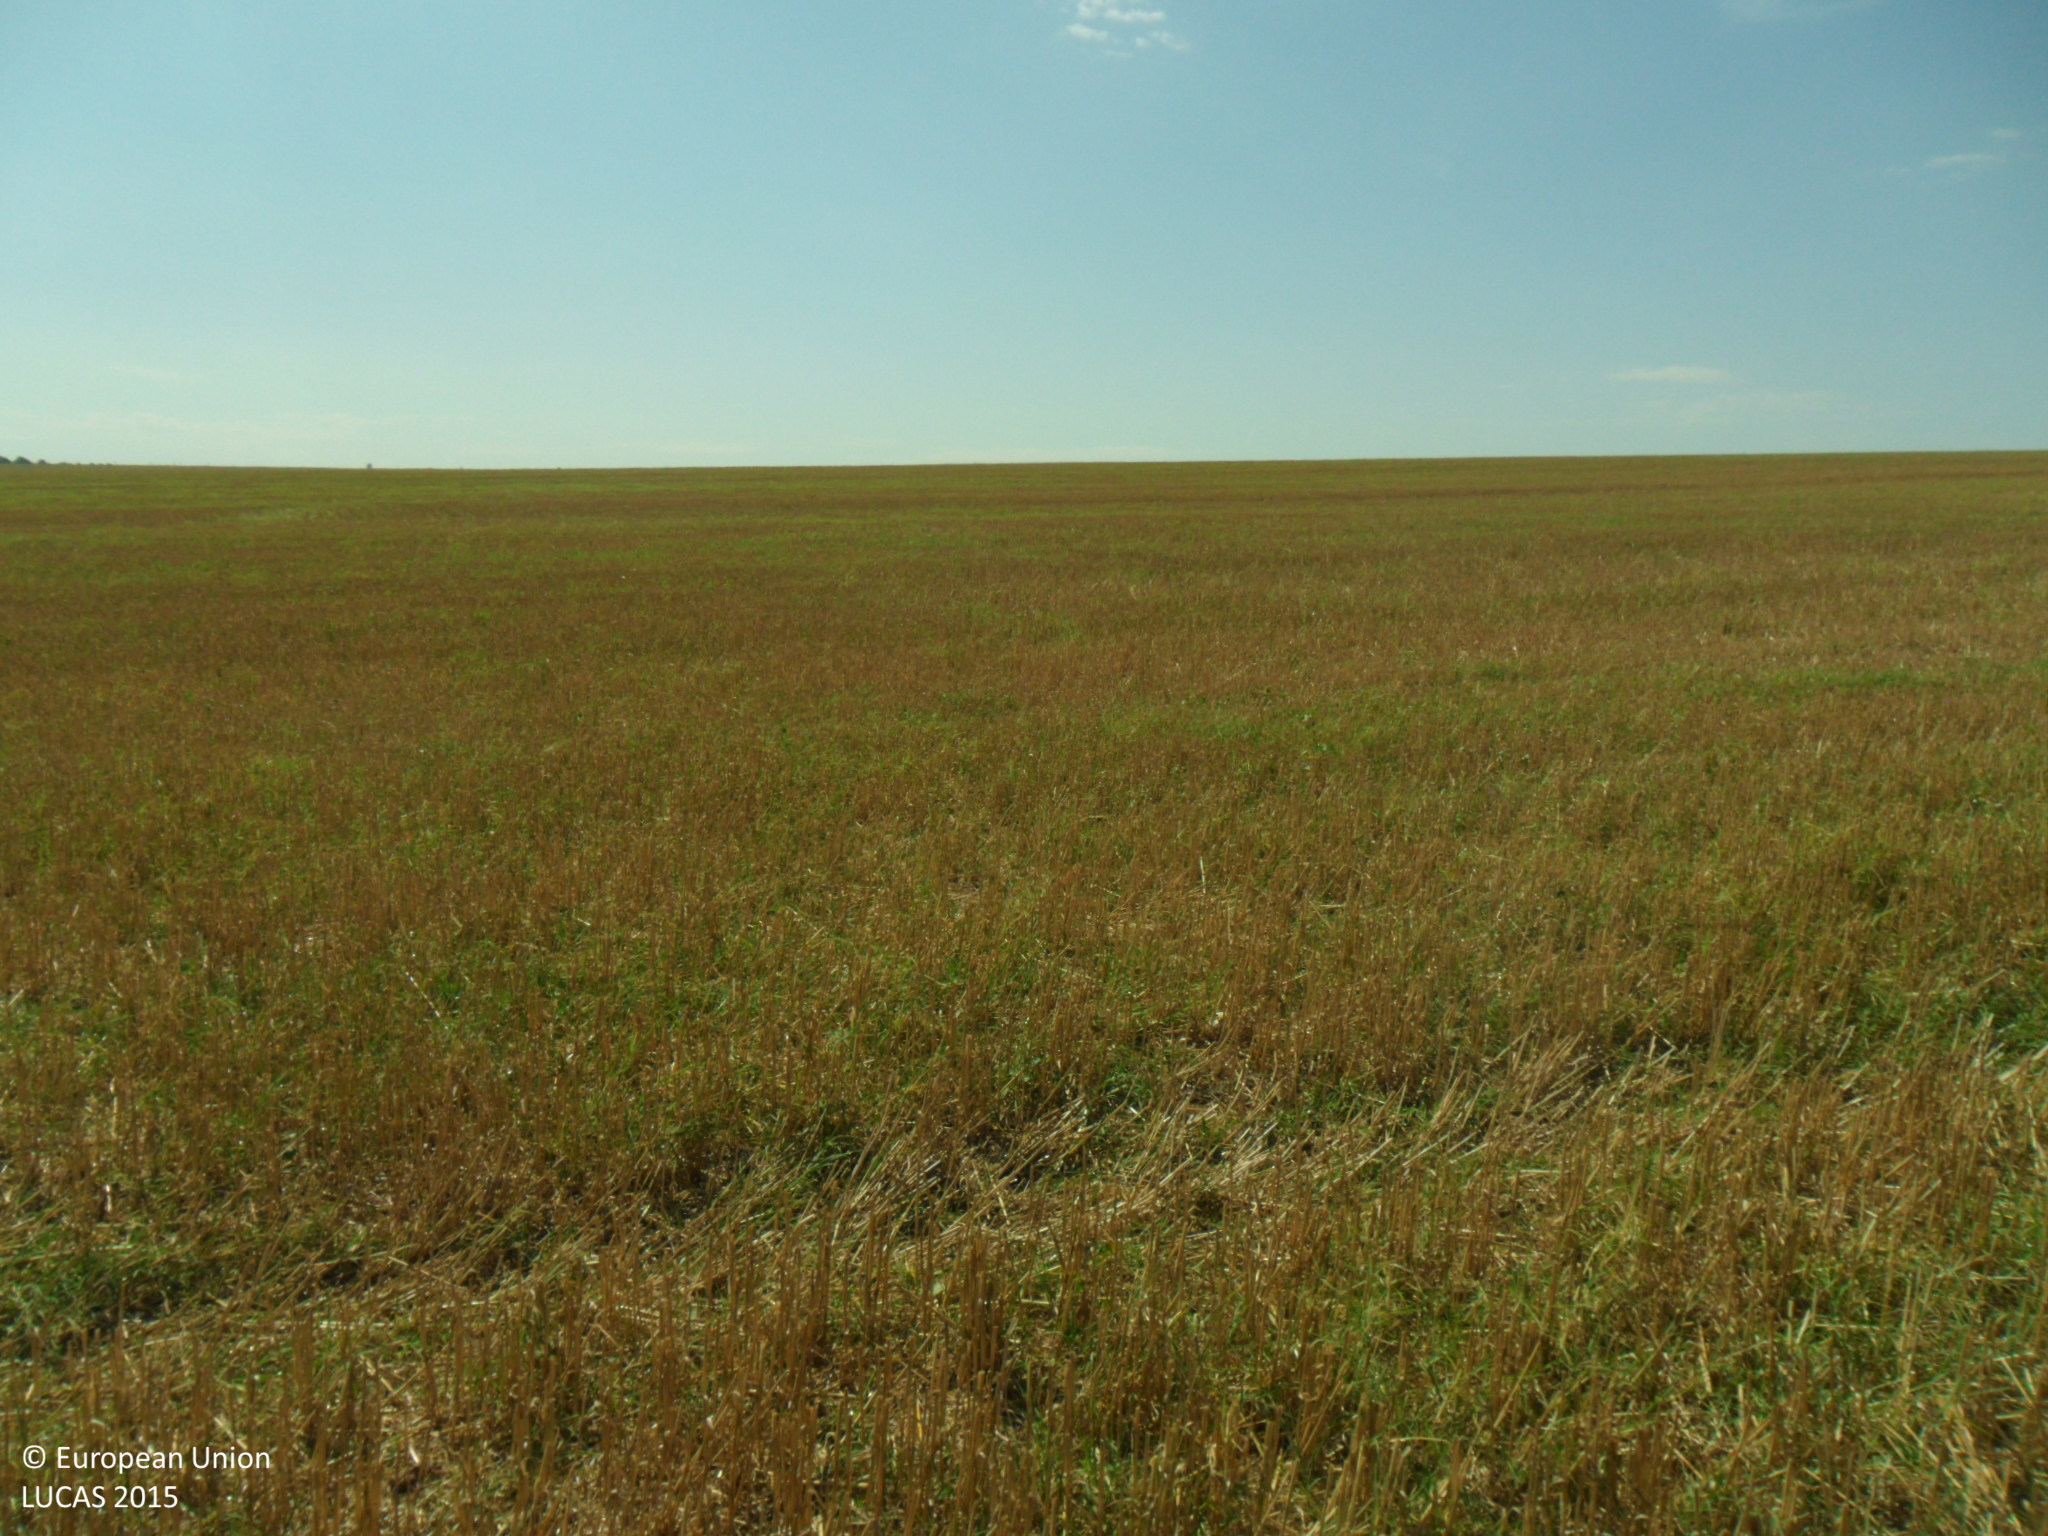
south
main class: Cropland
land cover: Common wheat
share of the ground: 50 - 75 %
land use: Agriculture (excluding fallow land and kitchen gardens)
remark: Harvested field
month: August
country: BG
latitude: 43.5937
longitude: 26.4677
